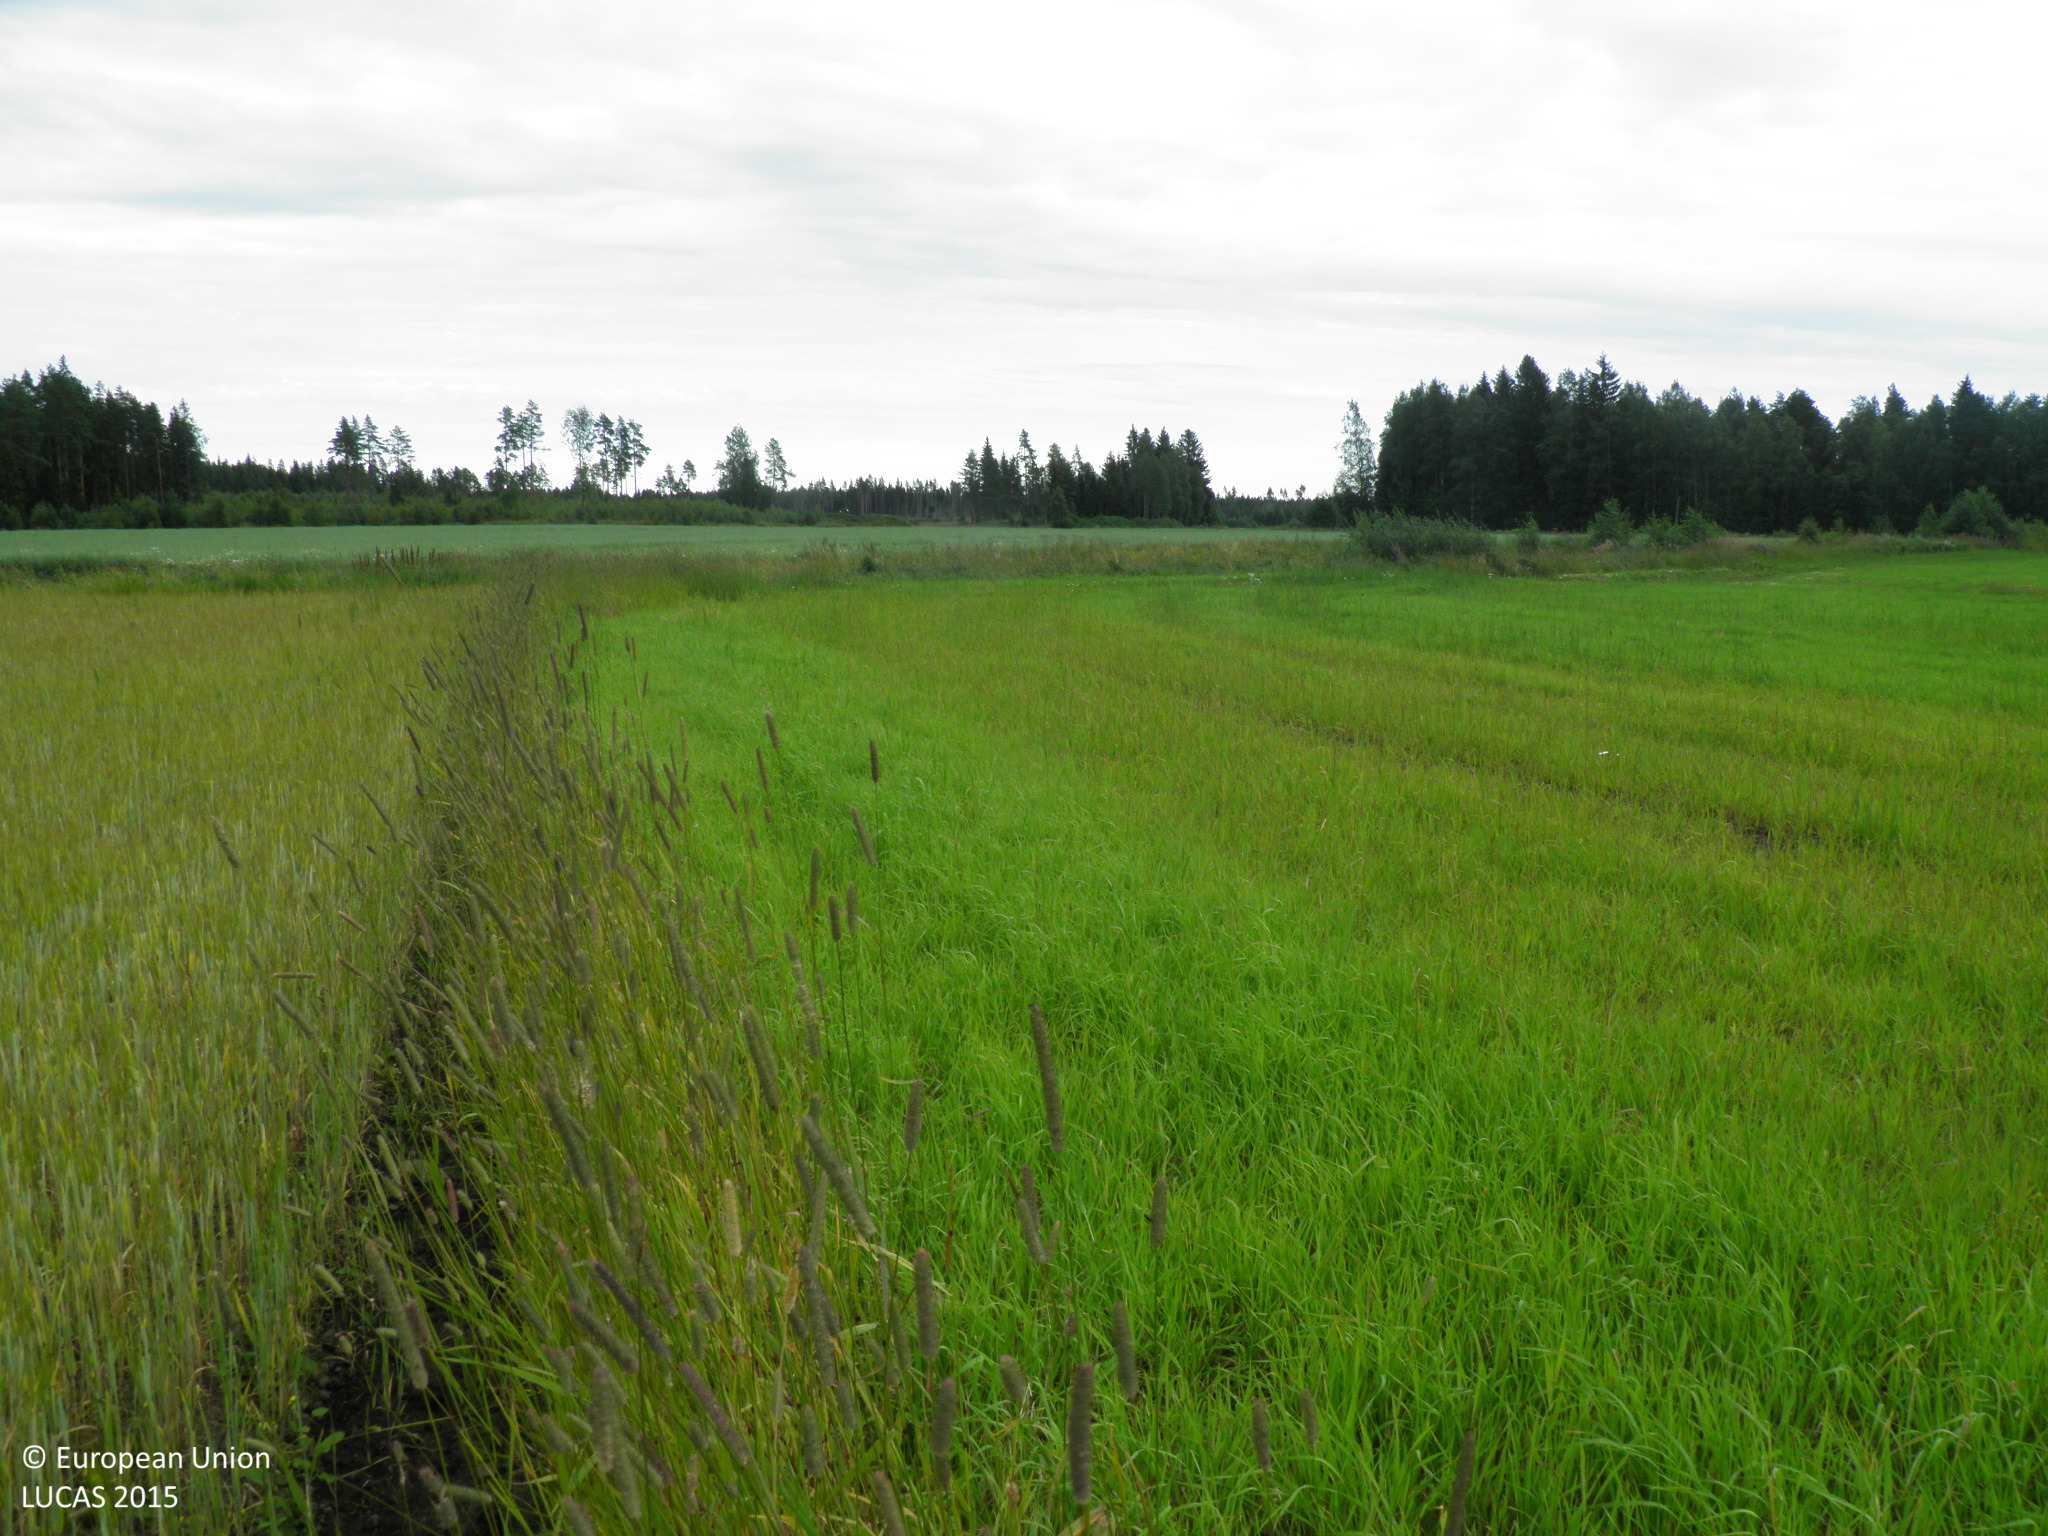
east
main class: Cropland
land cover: Barley
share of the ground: > 75 %
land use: Agriculture (excluding fallow land and kitchen gardens)
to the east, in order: Barley; Grass margins; Ditches and canals; Grass margins; Oats
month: August
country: FI
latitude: 61.0970
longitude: 22.9638
